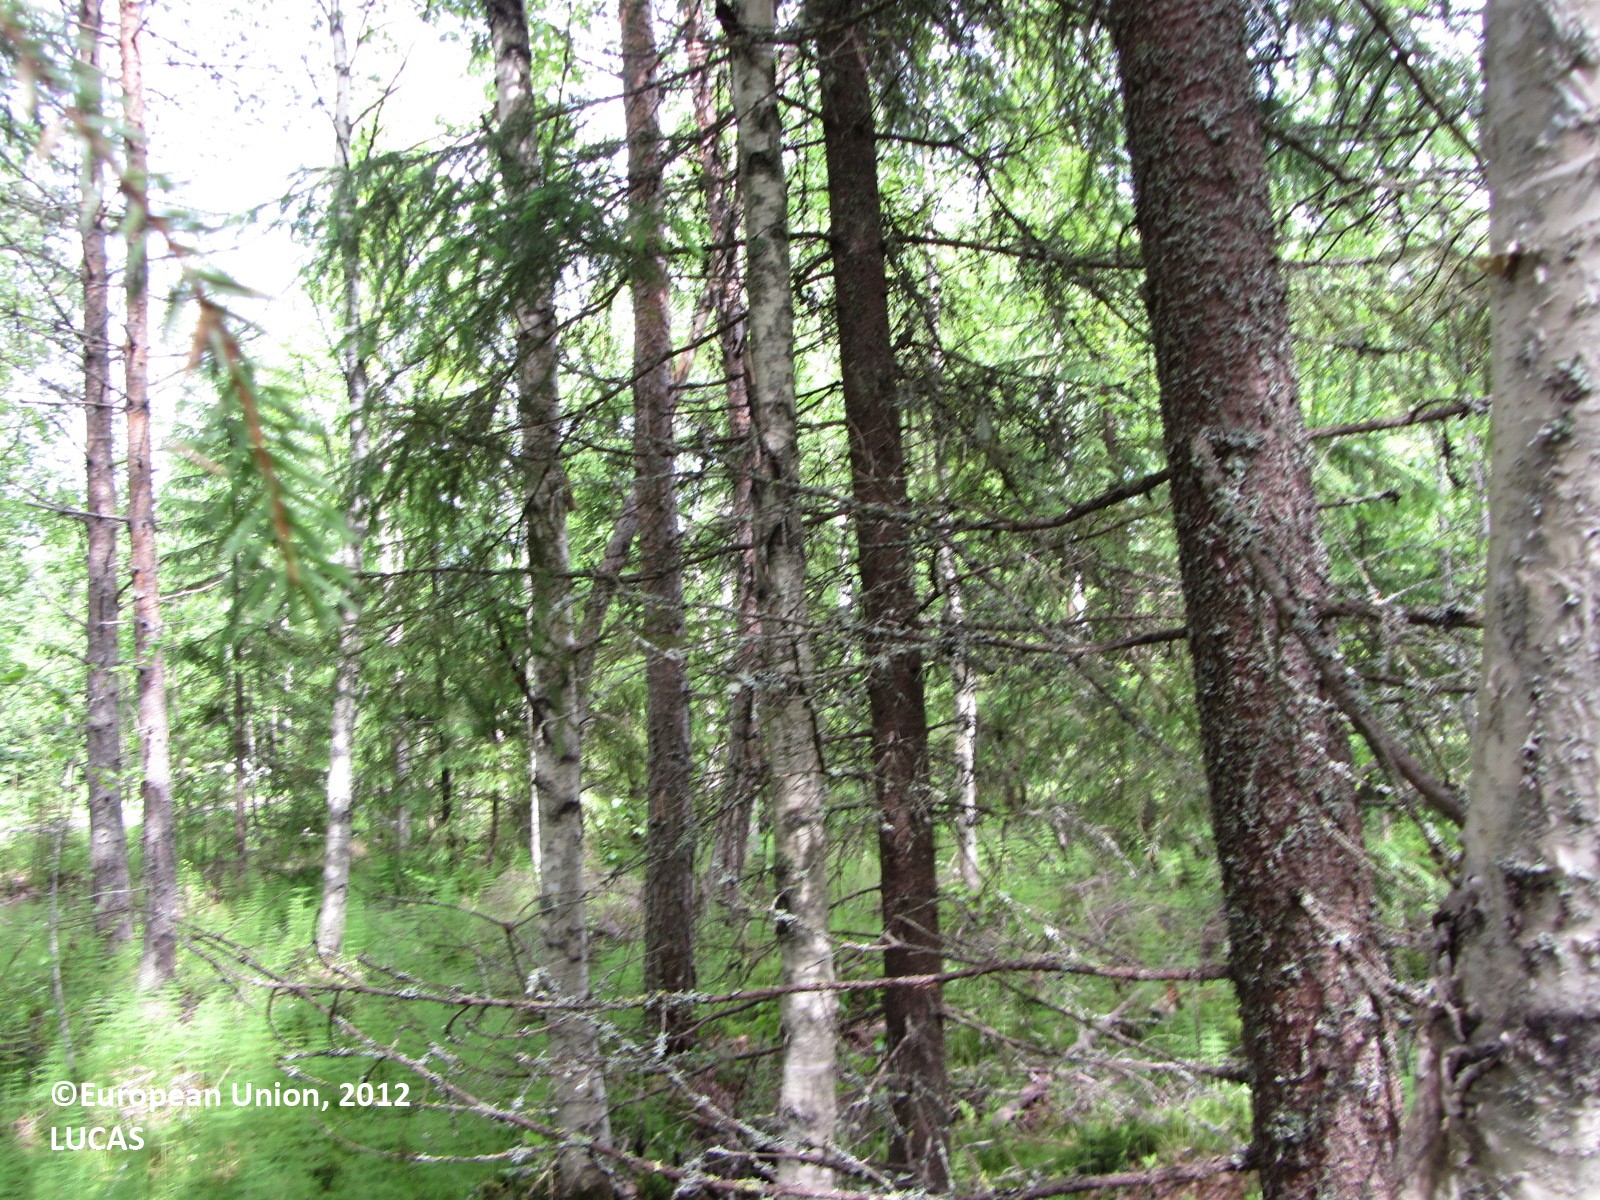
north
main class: Woodland
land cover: Other mixed woodland
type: boreal forest
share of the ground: > 75 %
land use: Forestry
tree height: > 5 m
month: June
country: FI
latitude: 62.6270
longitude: 25.0134
